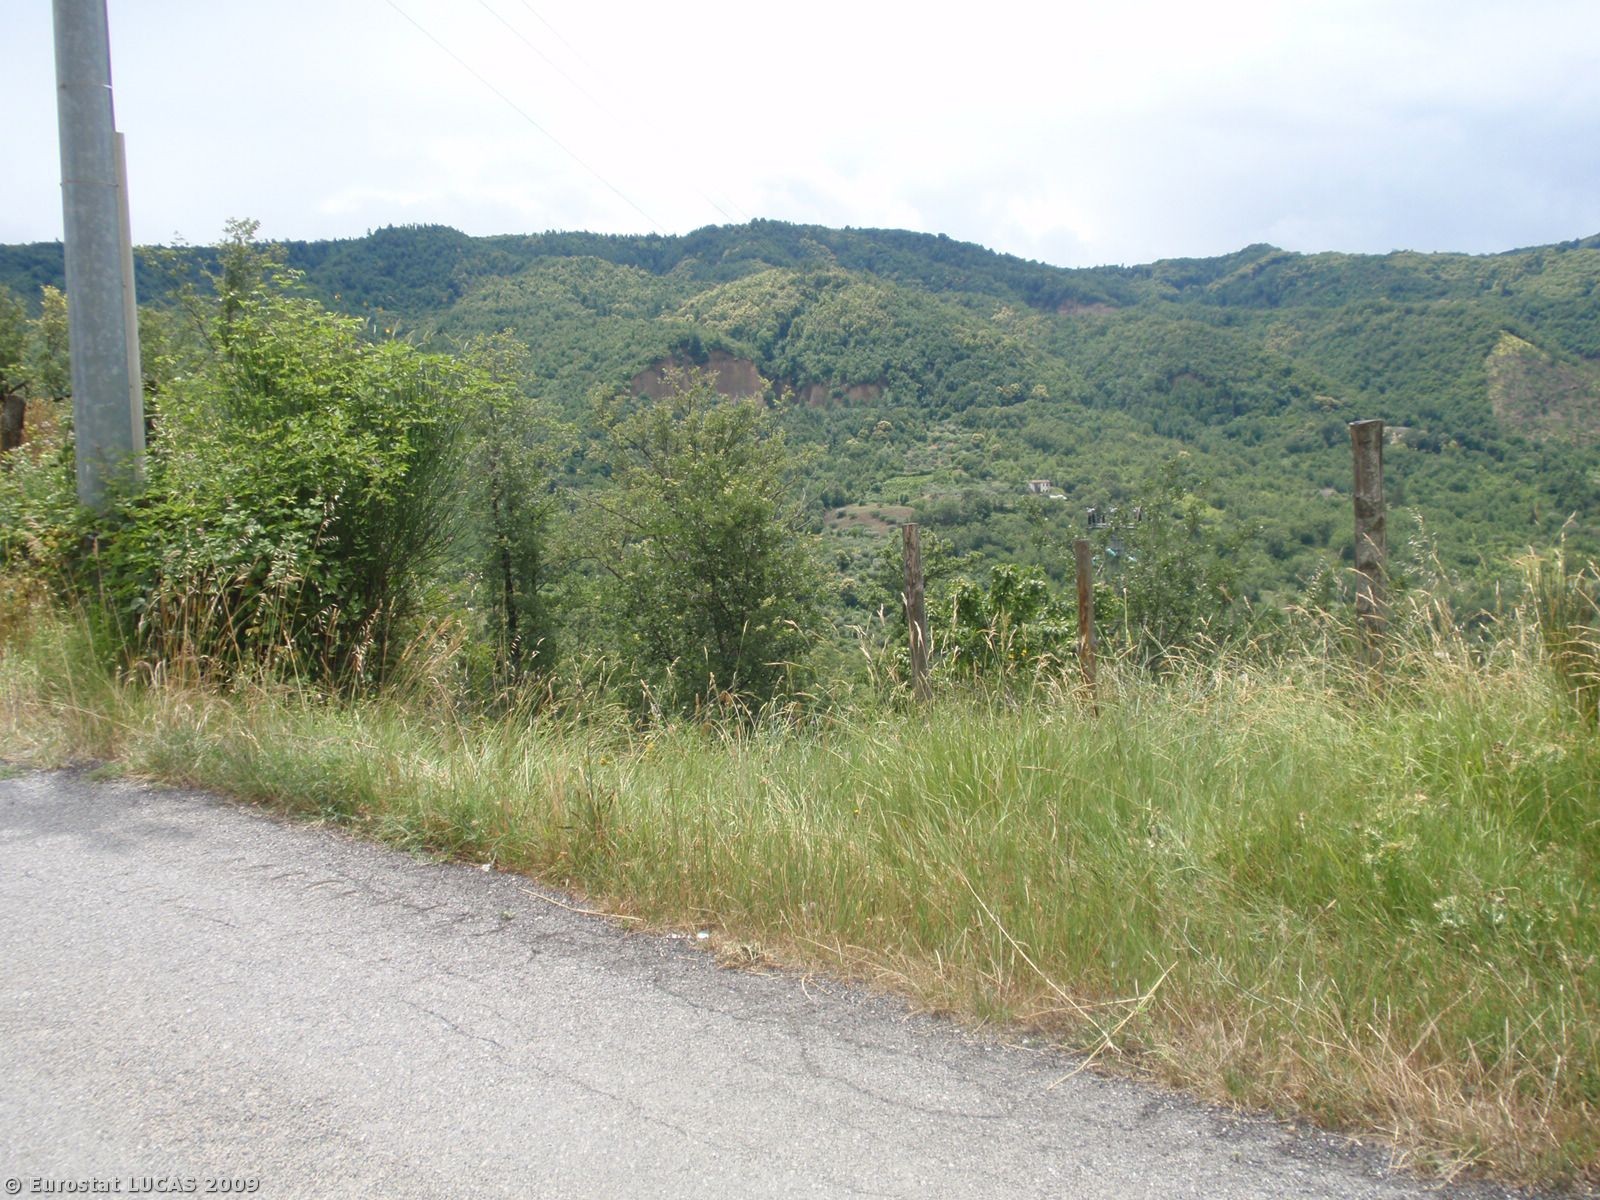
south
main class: Artificial land
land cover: Non built-up linear features
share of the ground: > 75 %
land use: Road transport
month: June
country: IT
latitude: 40.1881
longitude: 16.0708
